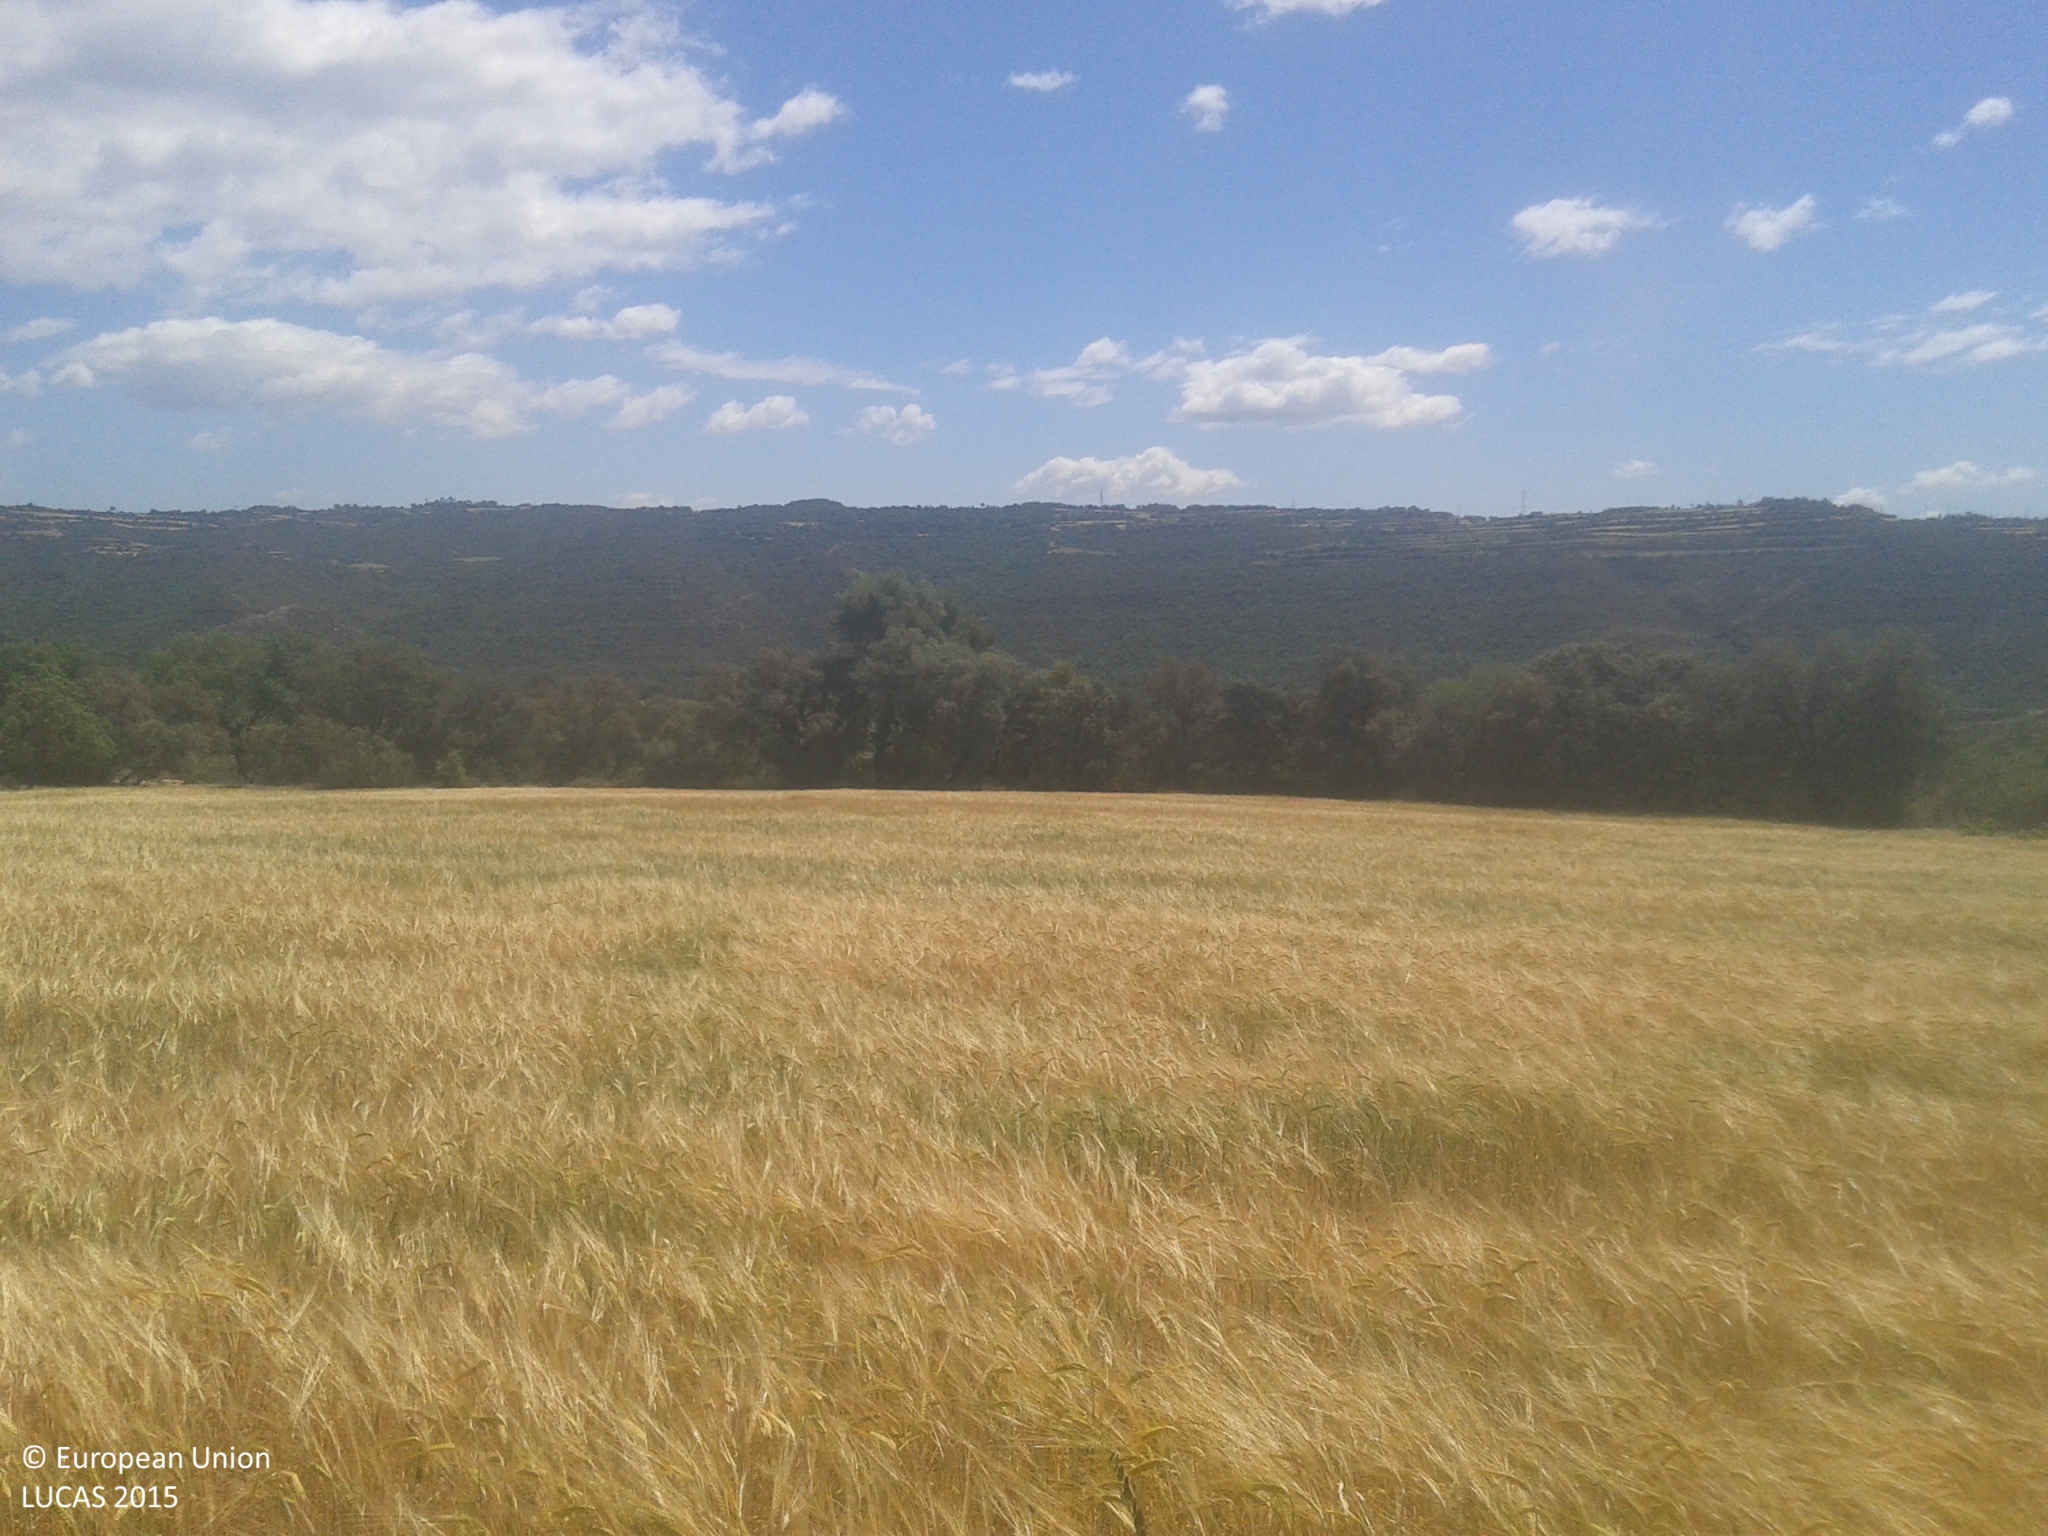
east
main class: Cropland
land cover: Barley
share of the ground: > 75 %
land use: Agriculture (excluding fallow land and kitchen gardens)
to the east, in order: Barley; Broadleaved woodland; Tracks; Shrubland without tree cover; Common wheat; Broadleaved woodland; Tracks; Common wheat
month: May
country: ES
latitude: 41.9567
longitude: 1.1440
